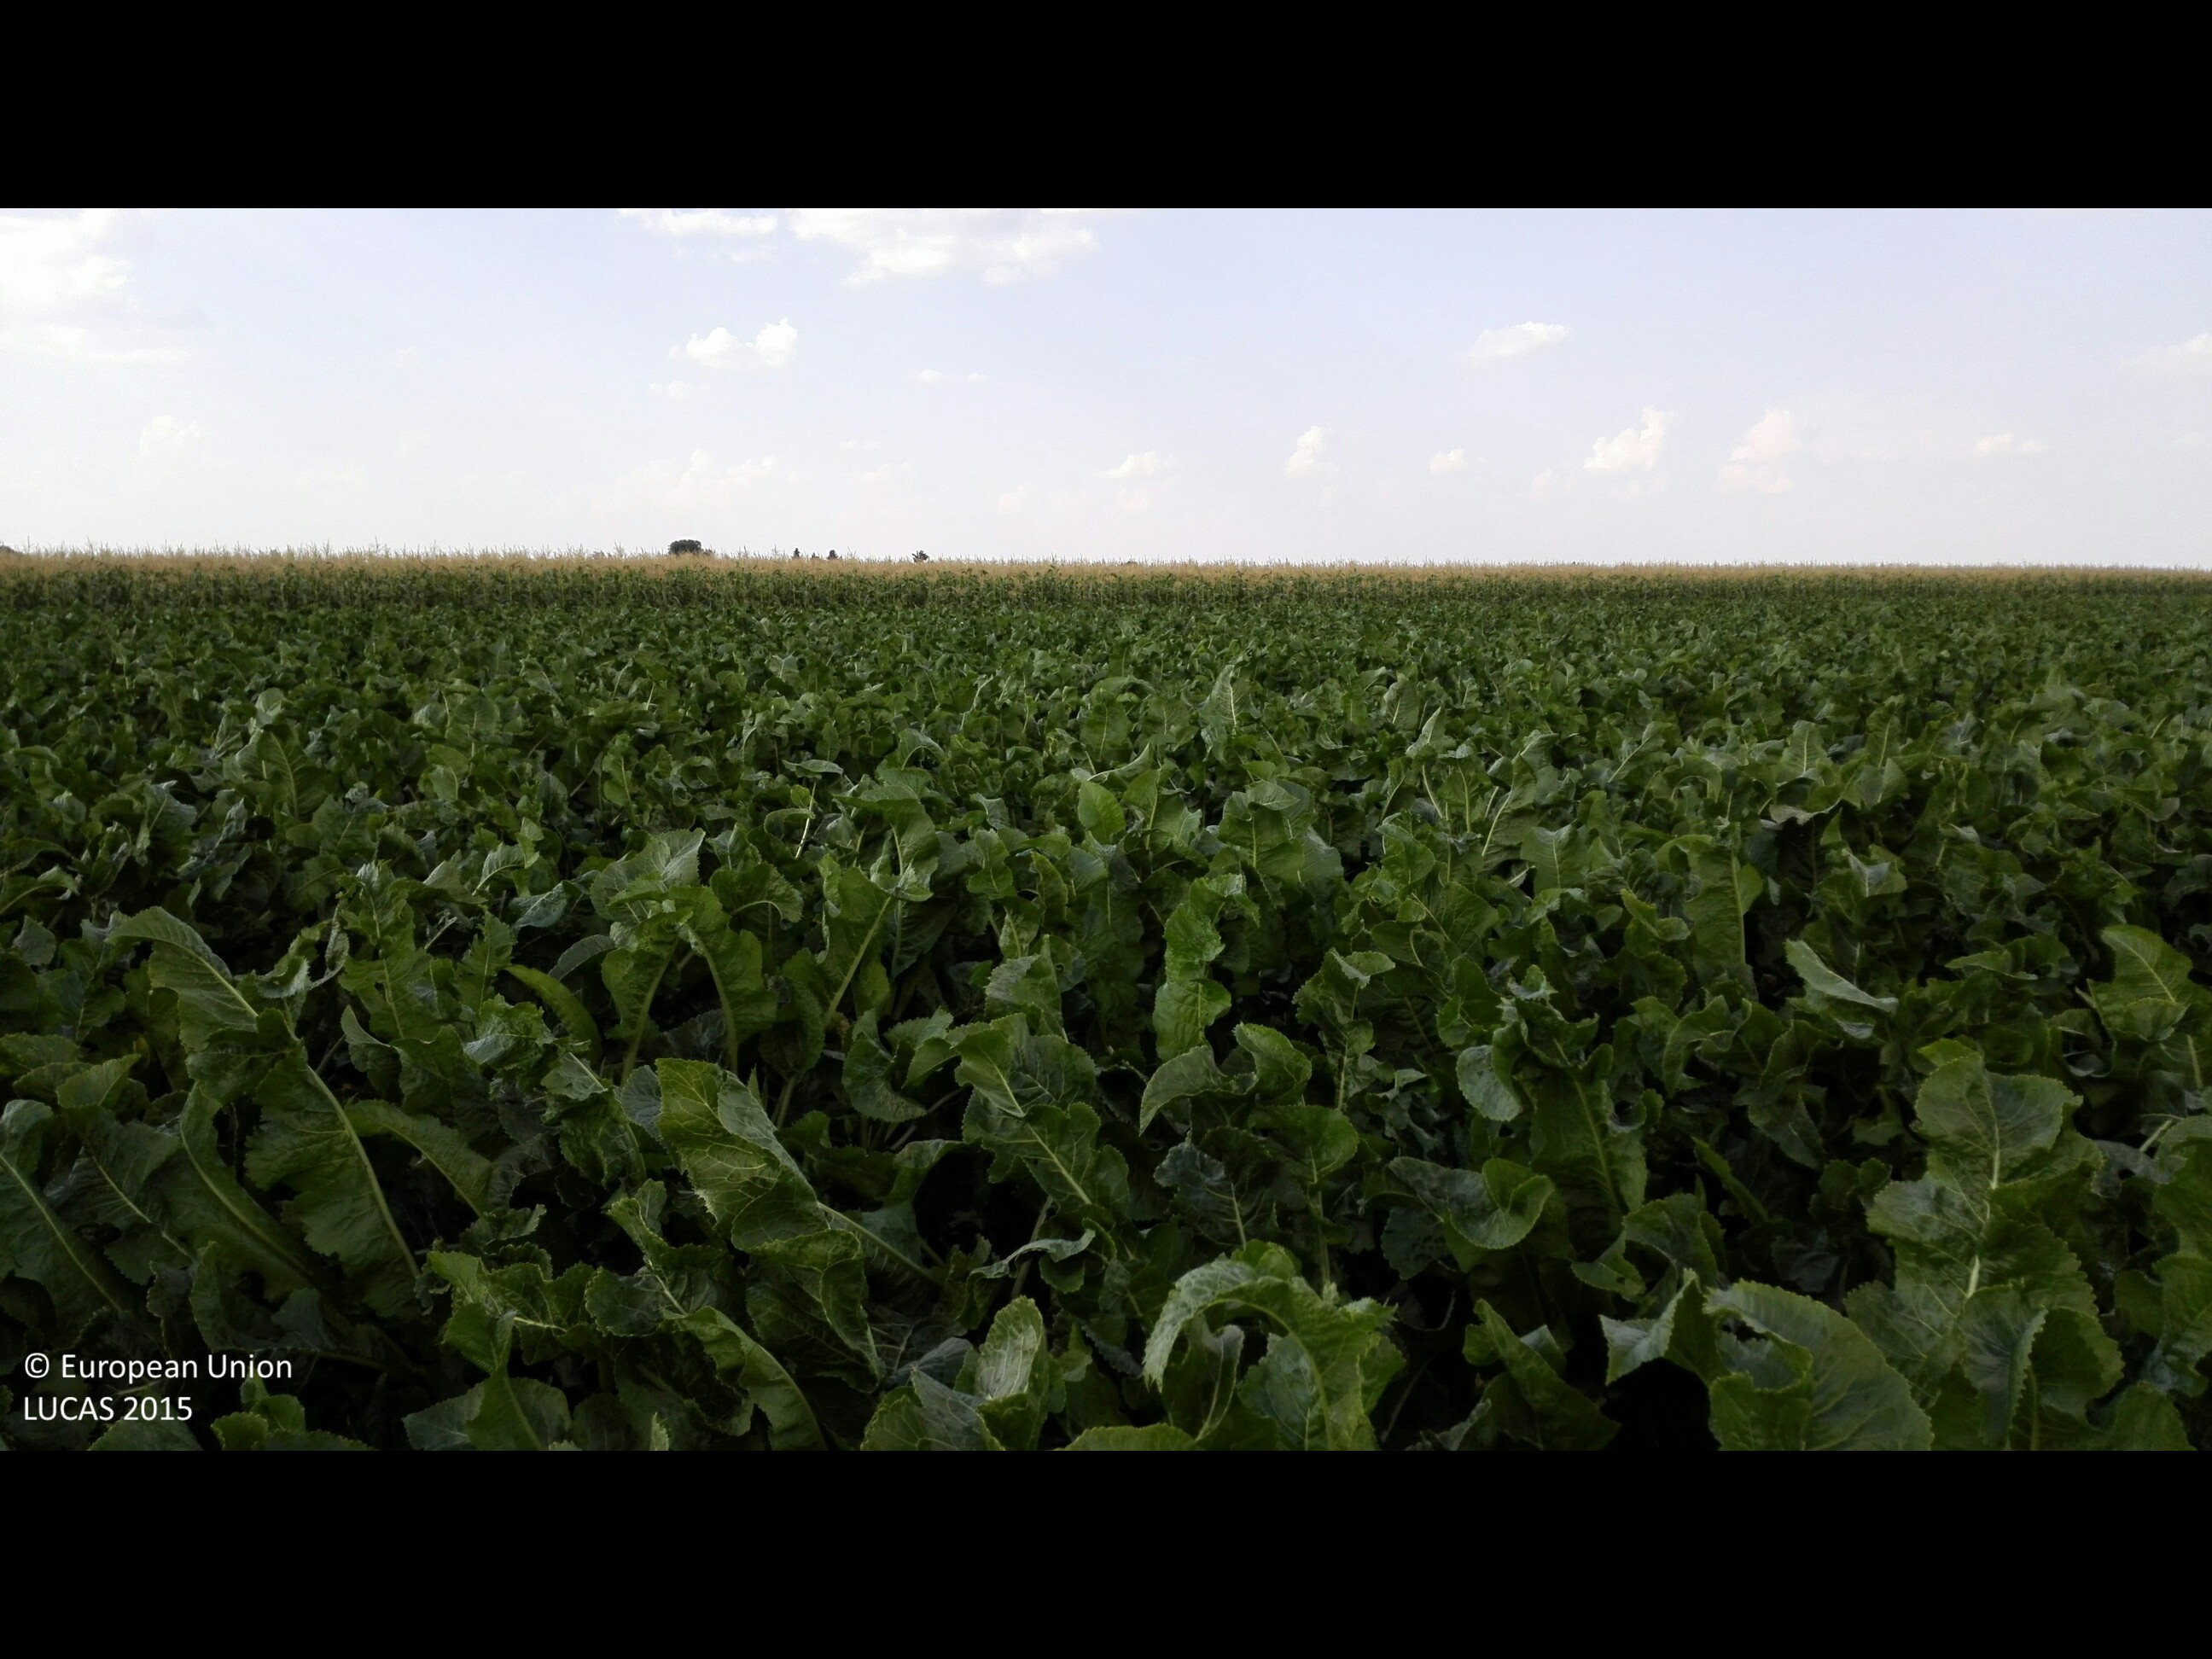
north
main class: Cropland
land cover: Other root crops
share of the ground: > 75 %
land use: Agriculture (excluding fallow land and kitchen gardens)
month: August
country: HU
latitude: 47.4029
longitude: 21.9880
